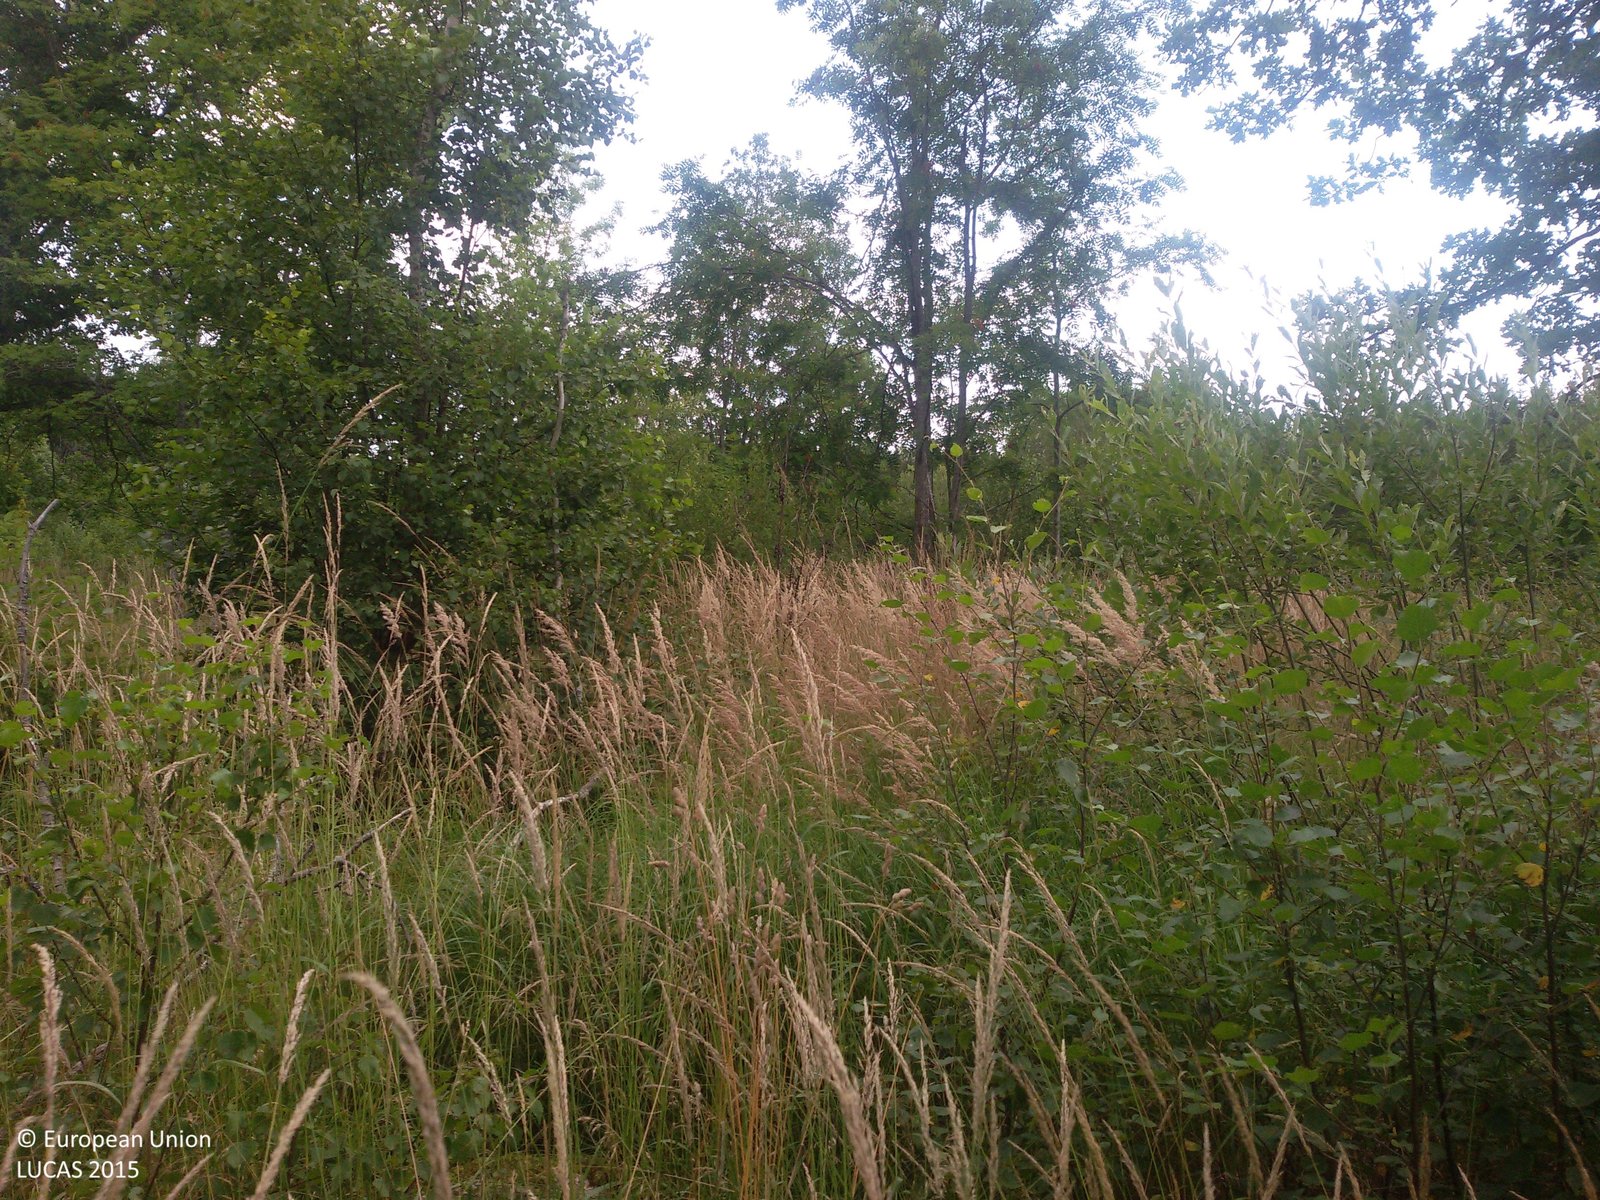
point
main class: Grassland
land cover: Grassland without tree/shrub cover
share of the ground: > 75 %
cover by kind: herbaceous plants 100 %
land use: Semi-natural and natural areas not in use
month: August
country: SE
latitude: 60.5712
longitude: 16.5384
